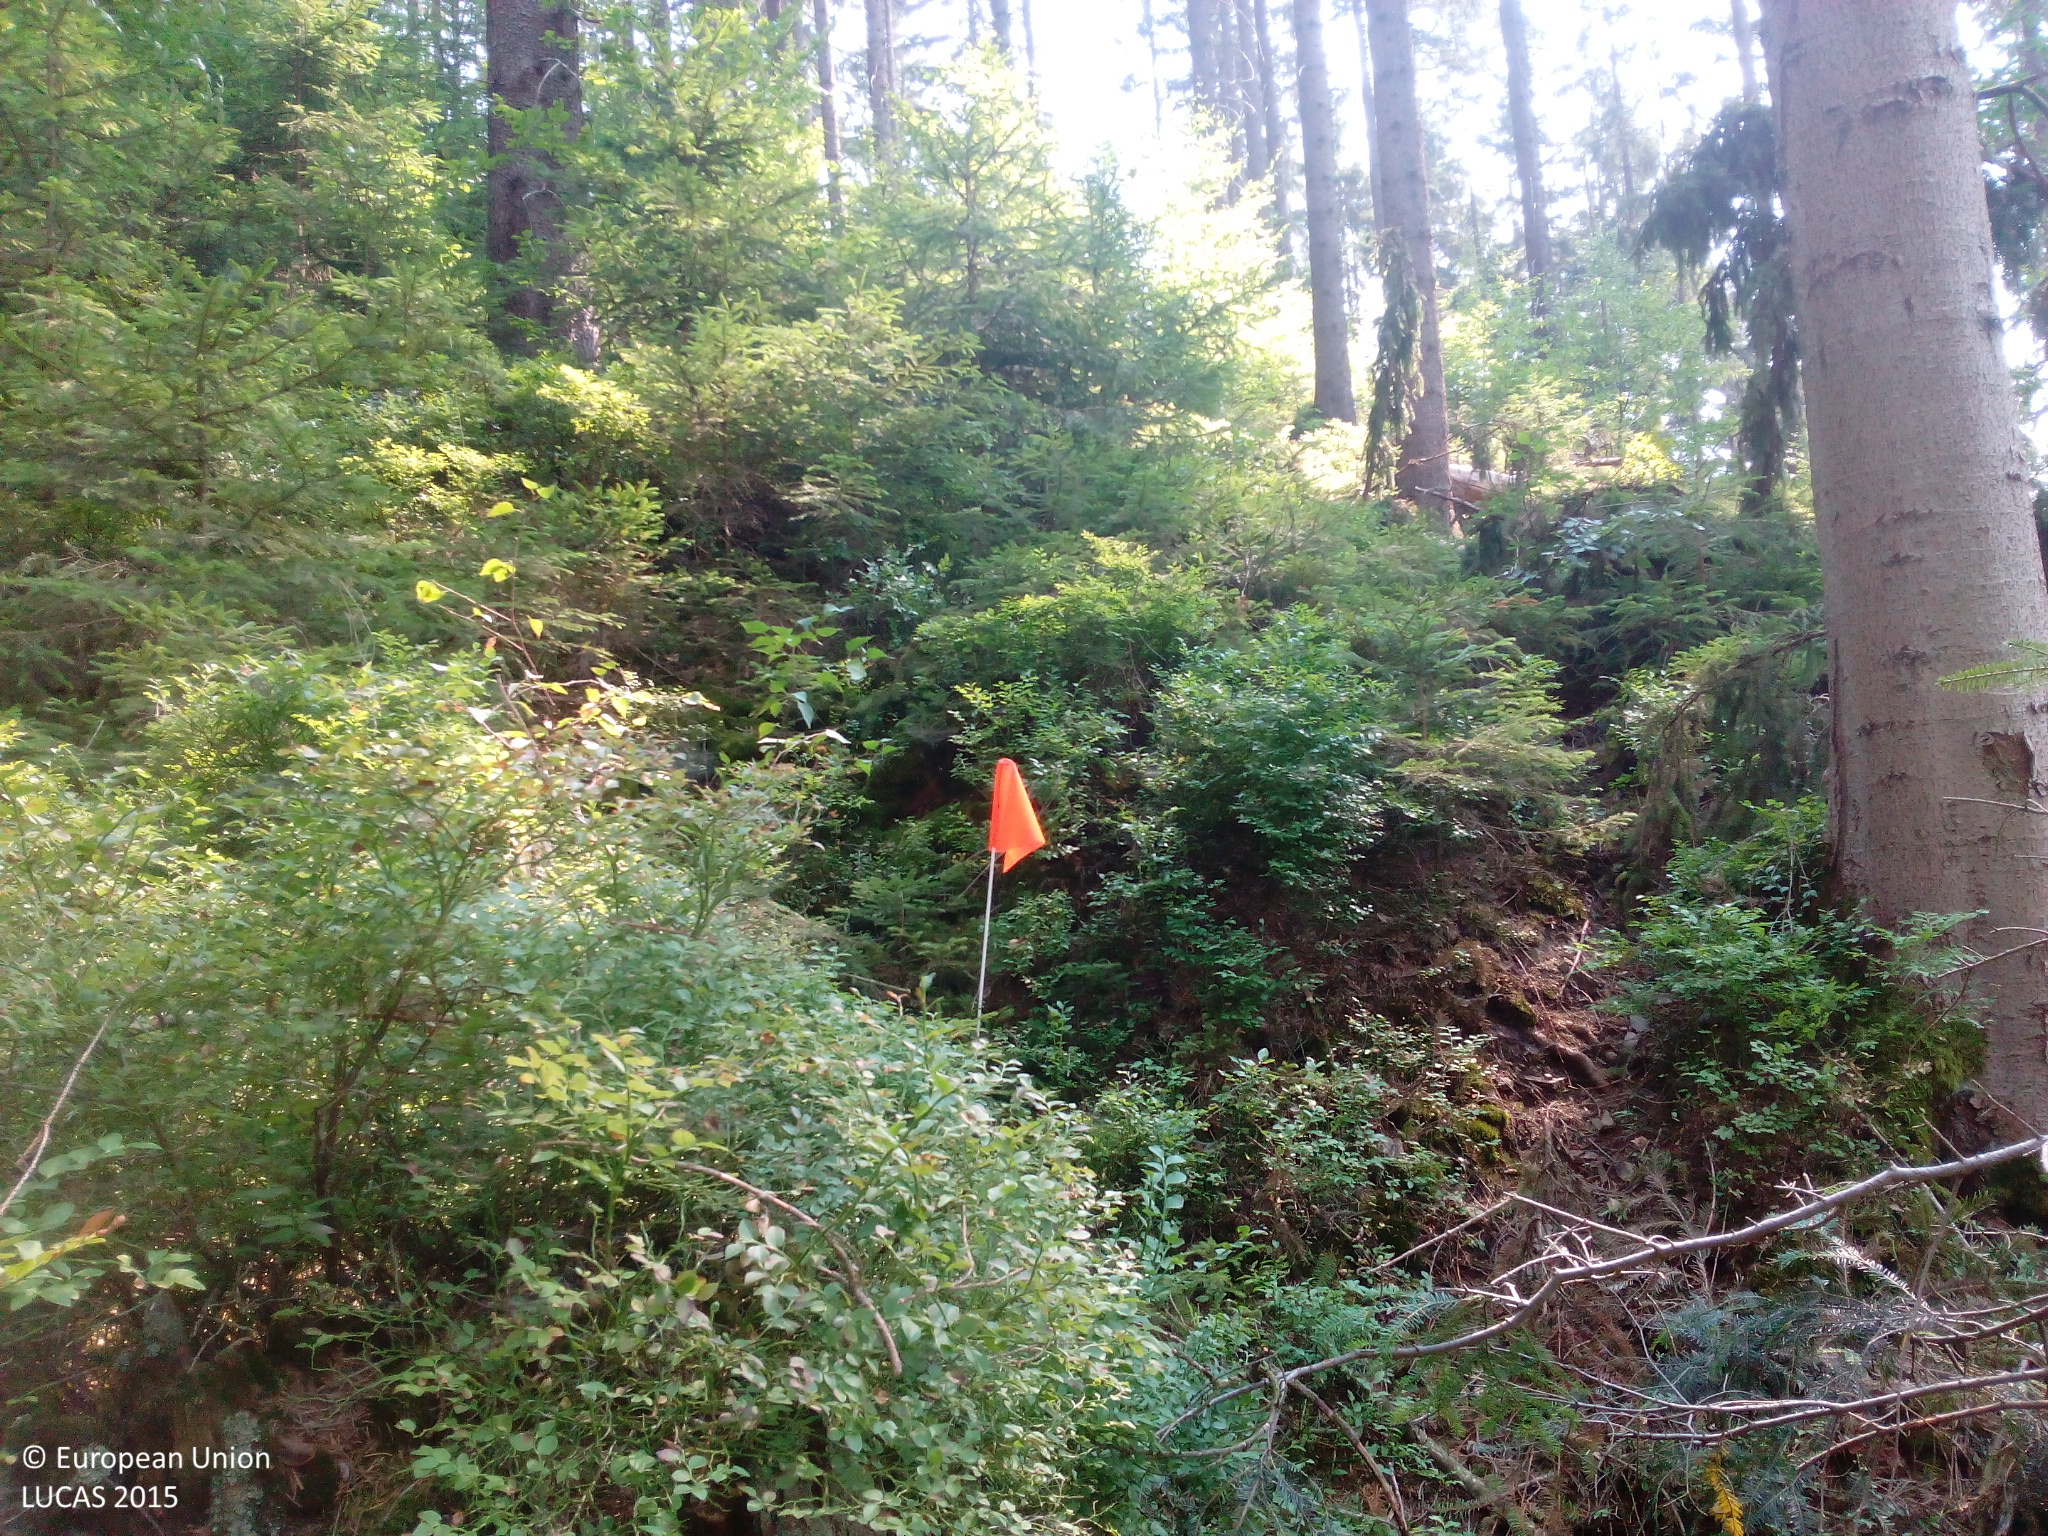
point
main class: Woodland
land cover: Spruce dominated coniferous woodland
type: hemiboreal forest and nemoral coniferous forest and mixed broadleaved-coniferous forest
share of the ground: > 75 %
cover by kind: coniferous forest trees 90 %, shrubs 10 %
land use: Forestry
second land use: Amenities, museums, leisure
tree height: > 5 m
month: August
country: DE
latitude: 50.2991
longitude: 11.5860
